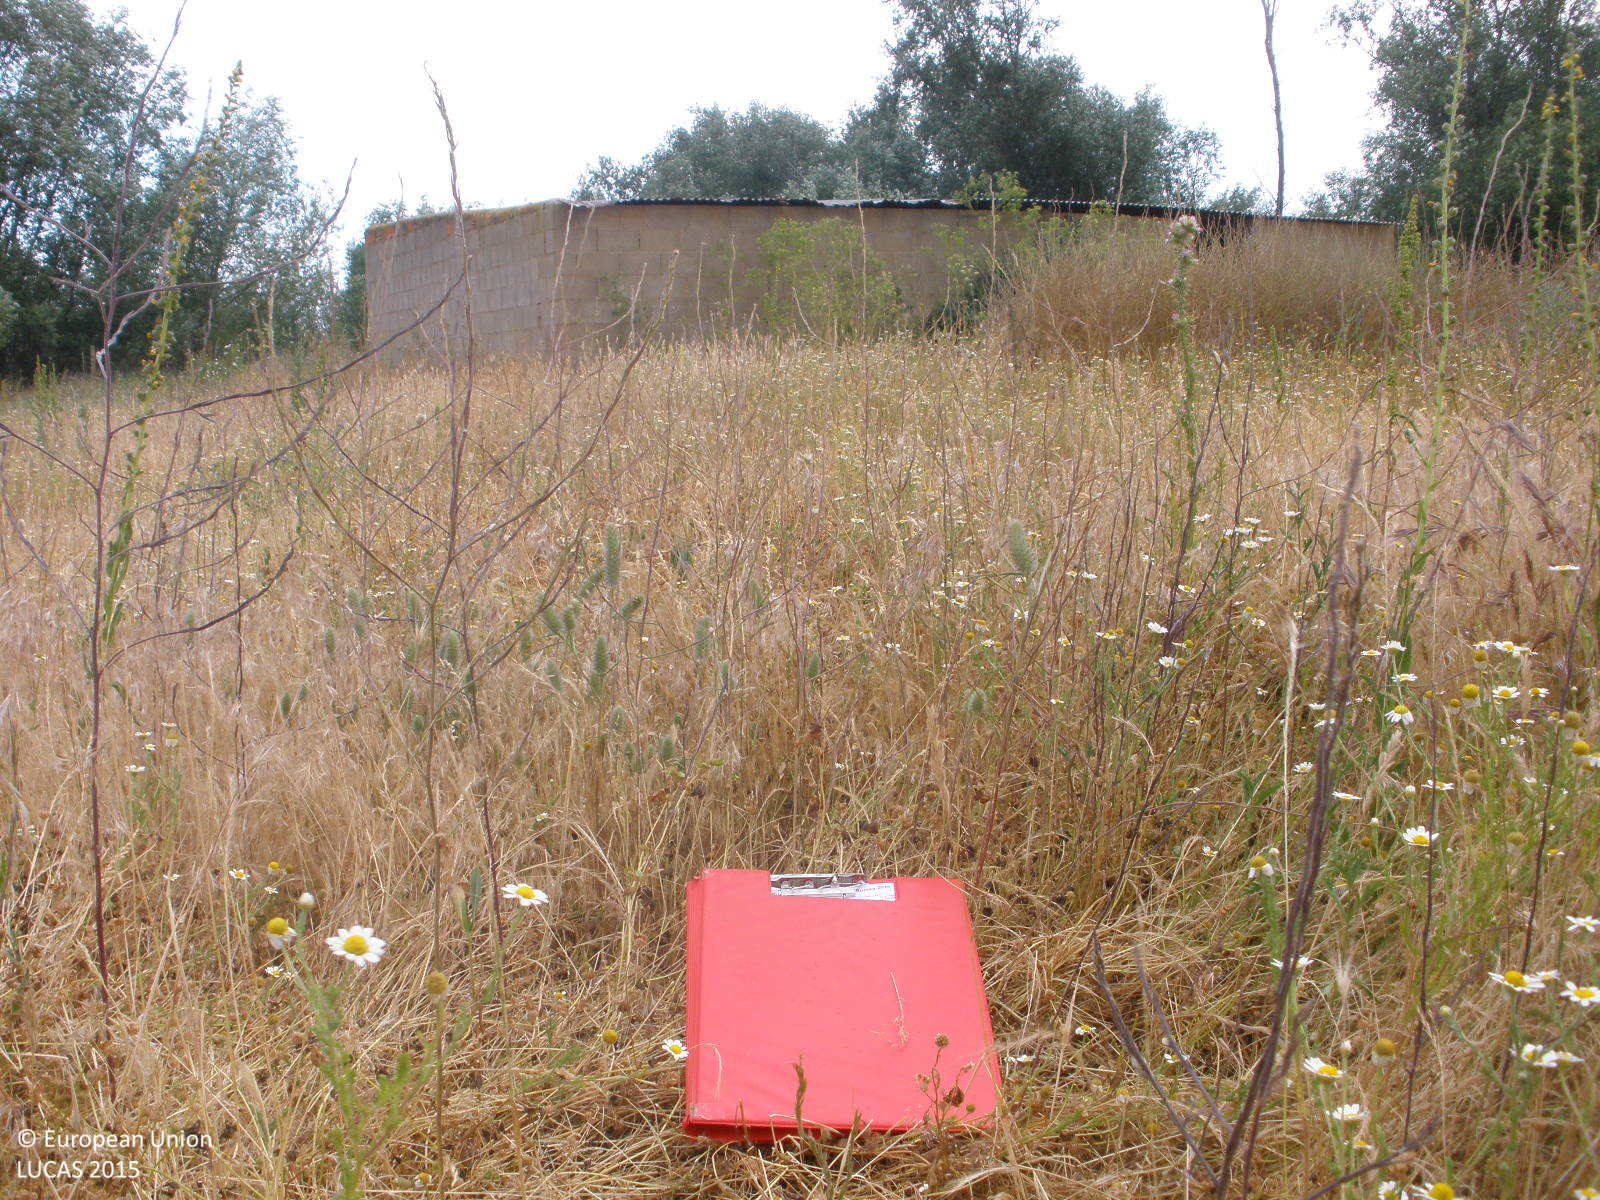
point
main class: Grassland
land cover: Grassland without tree/shrub cover
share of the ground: > 75 %
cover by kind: herbaceous plants 100 %
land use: Agriculture (excluding fallow land and kitchen gardens)
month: June
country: ES
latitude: 40.7152
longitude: -6.1954
